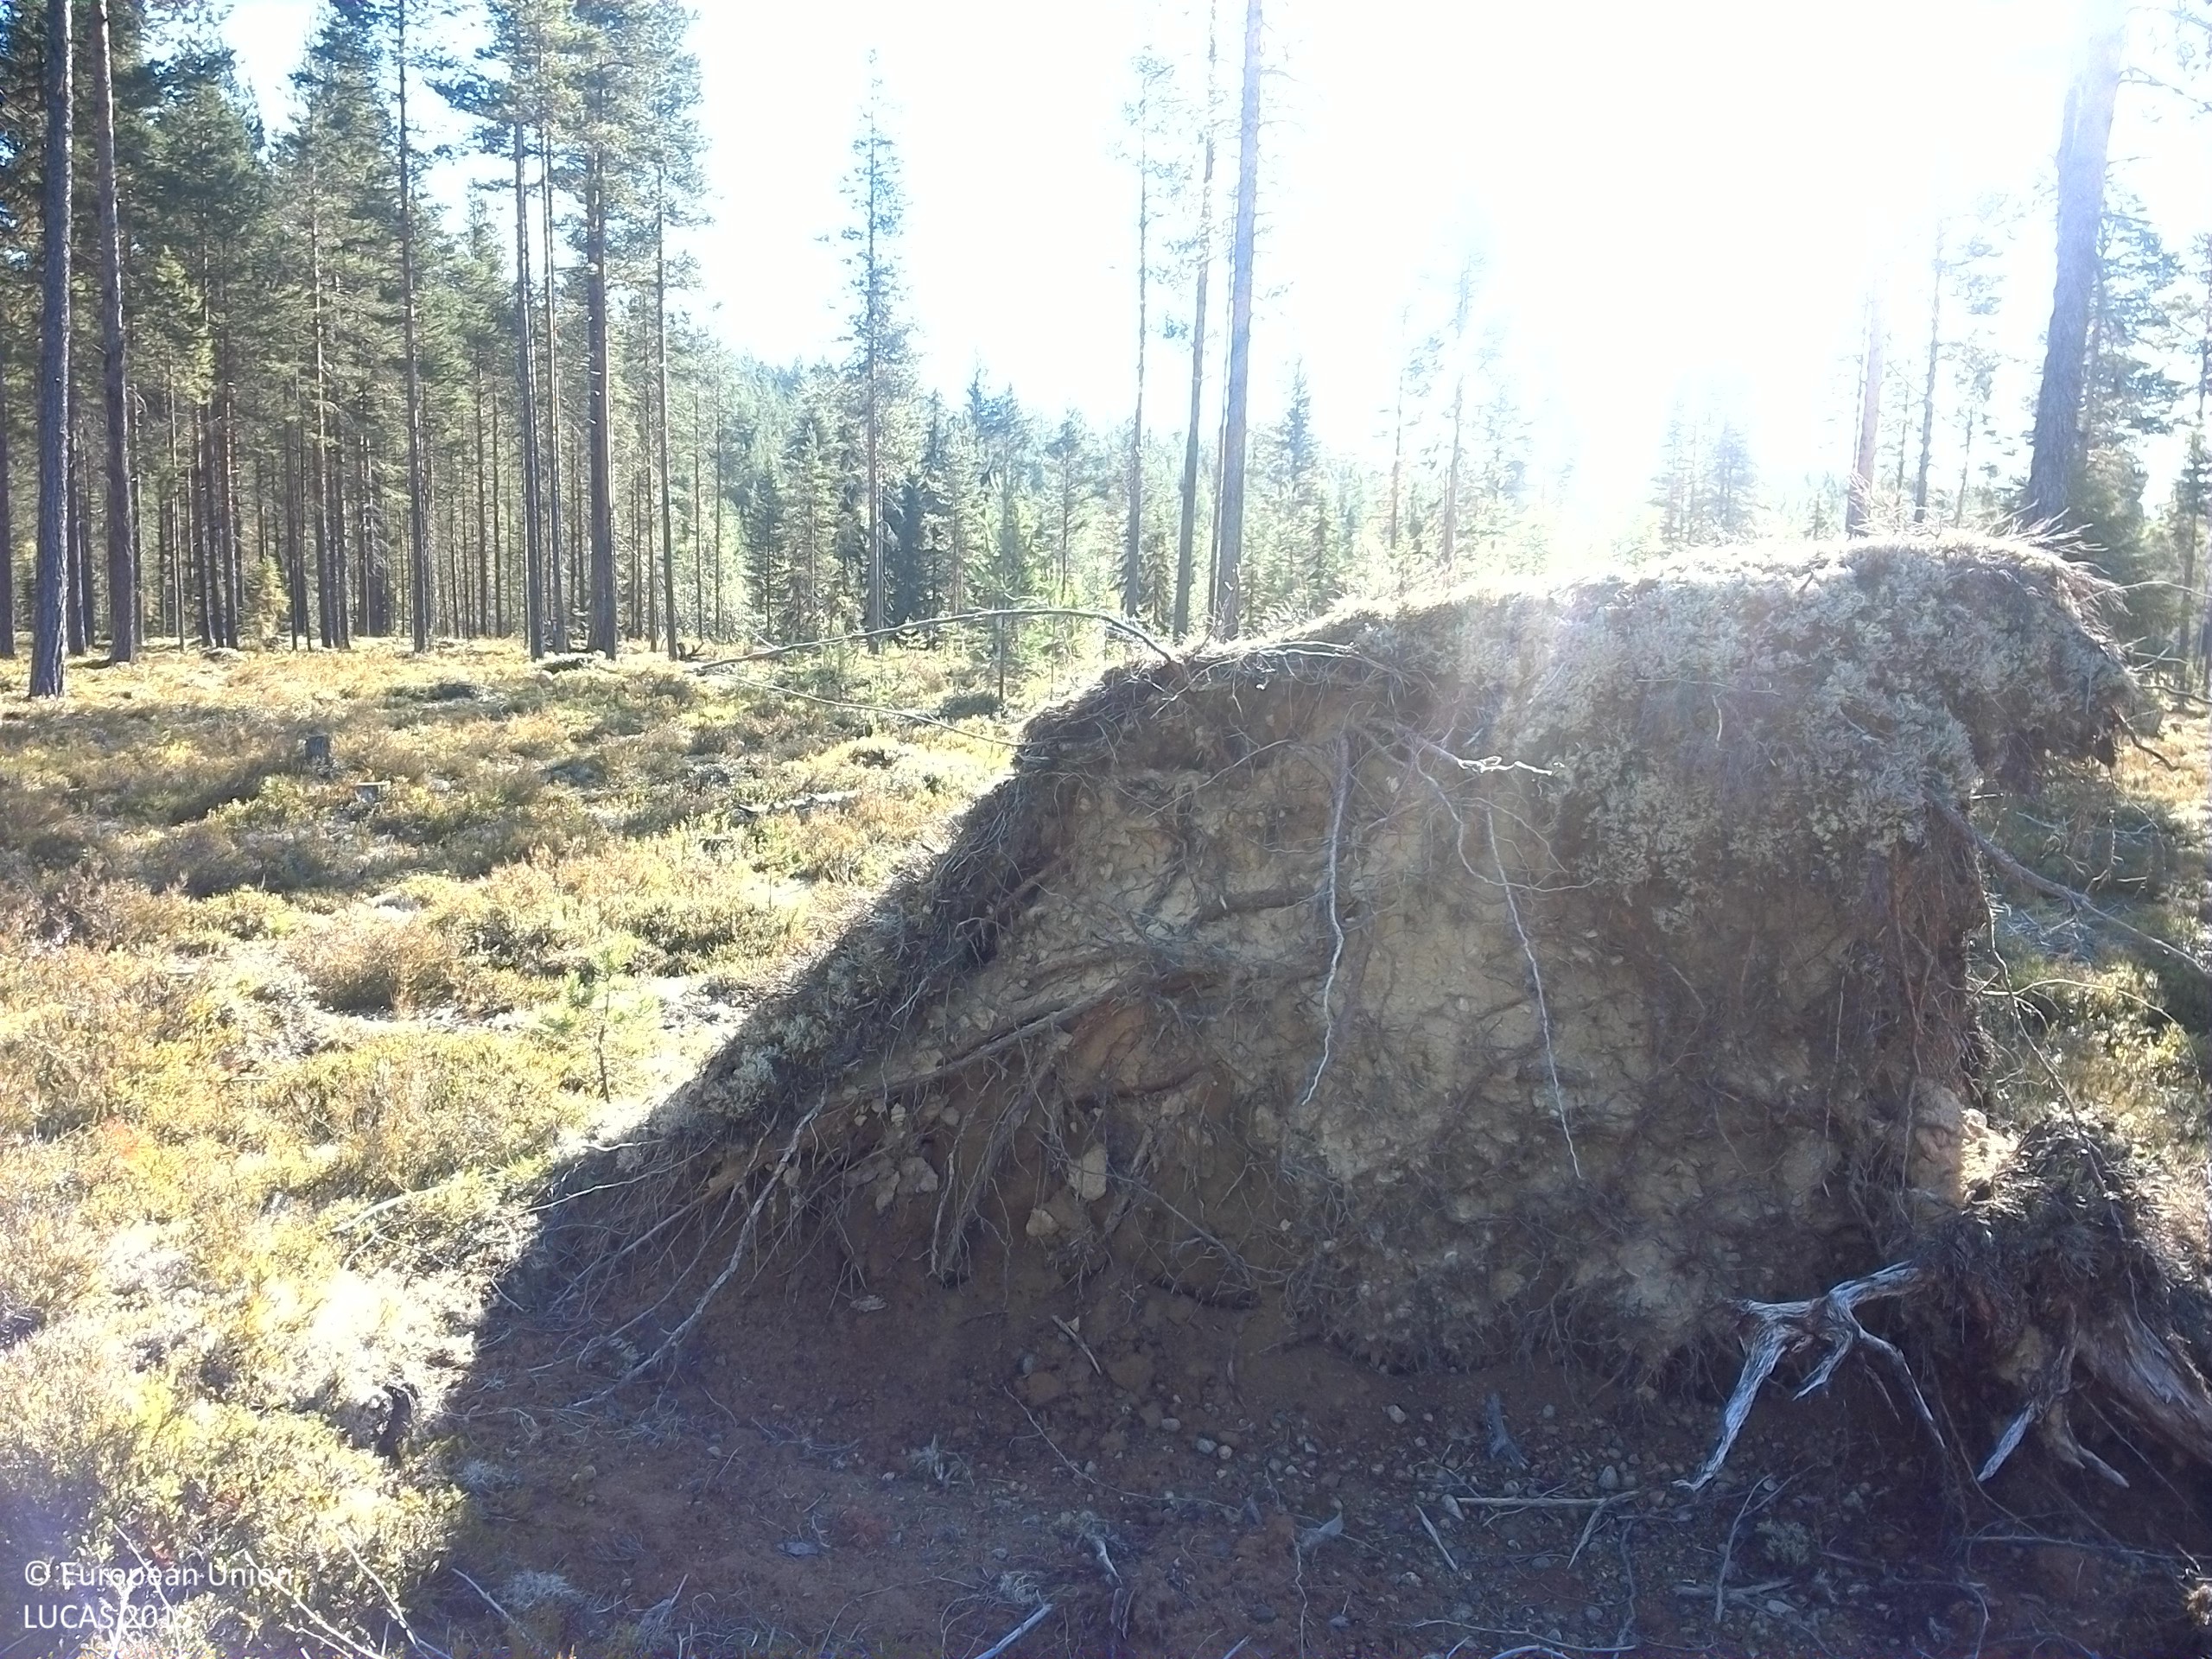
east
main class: Shrubland
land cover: Shrubland with sparse tree cover
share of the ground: 50 - 75 %
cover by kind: shrubs 60 %, lichens and mosses 35 %, coniferous forest trees 5 %
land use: Forestry
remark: Clear cut
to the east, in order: Shrubland with sparse tree cover; Pine dominated mixed woodland; Spruce dominated mixed woodland; Pine dominated coniferous woodland
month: August
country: SE
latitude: 63.7534
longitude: 16.5997
